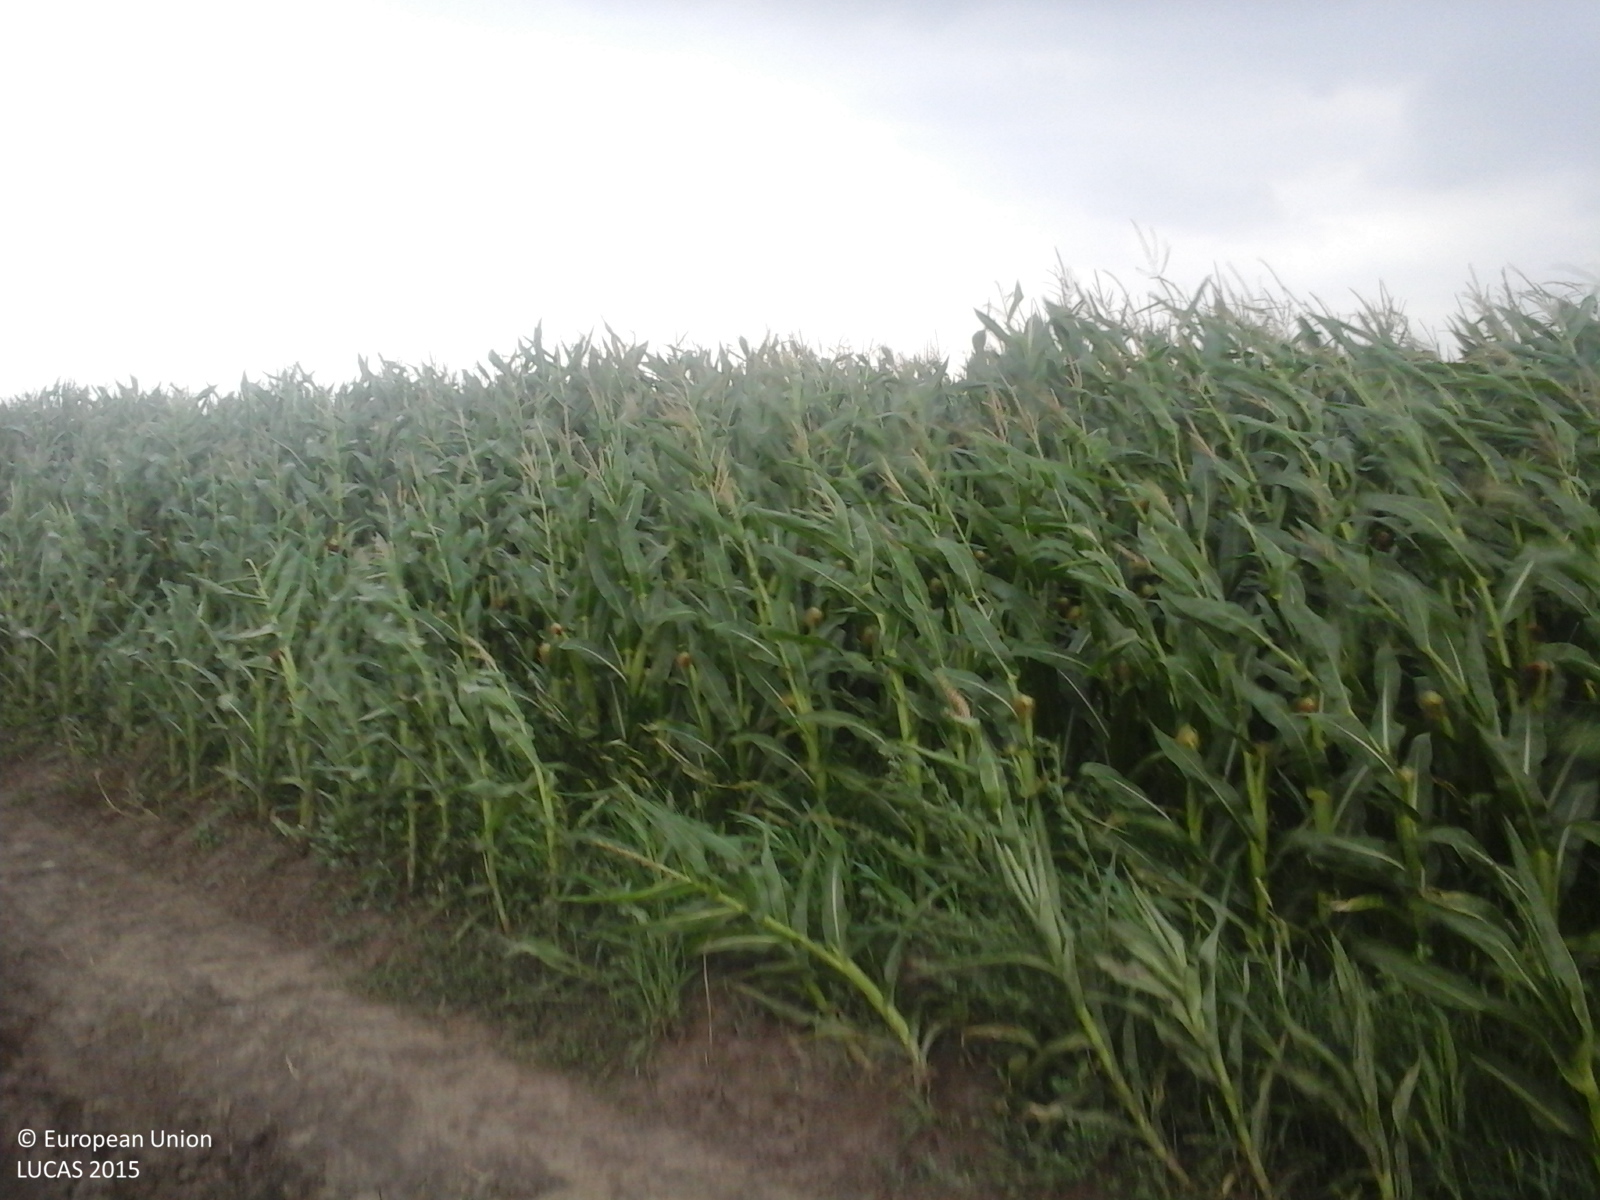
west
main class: Cropland
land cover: Maize
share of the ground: > 75 %
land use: Agriculture (excluding fallow land and kitchen gardens)
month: July
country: RO
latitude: 43.7734
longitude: 25.6802
